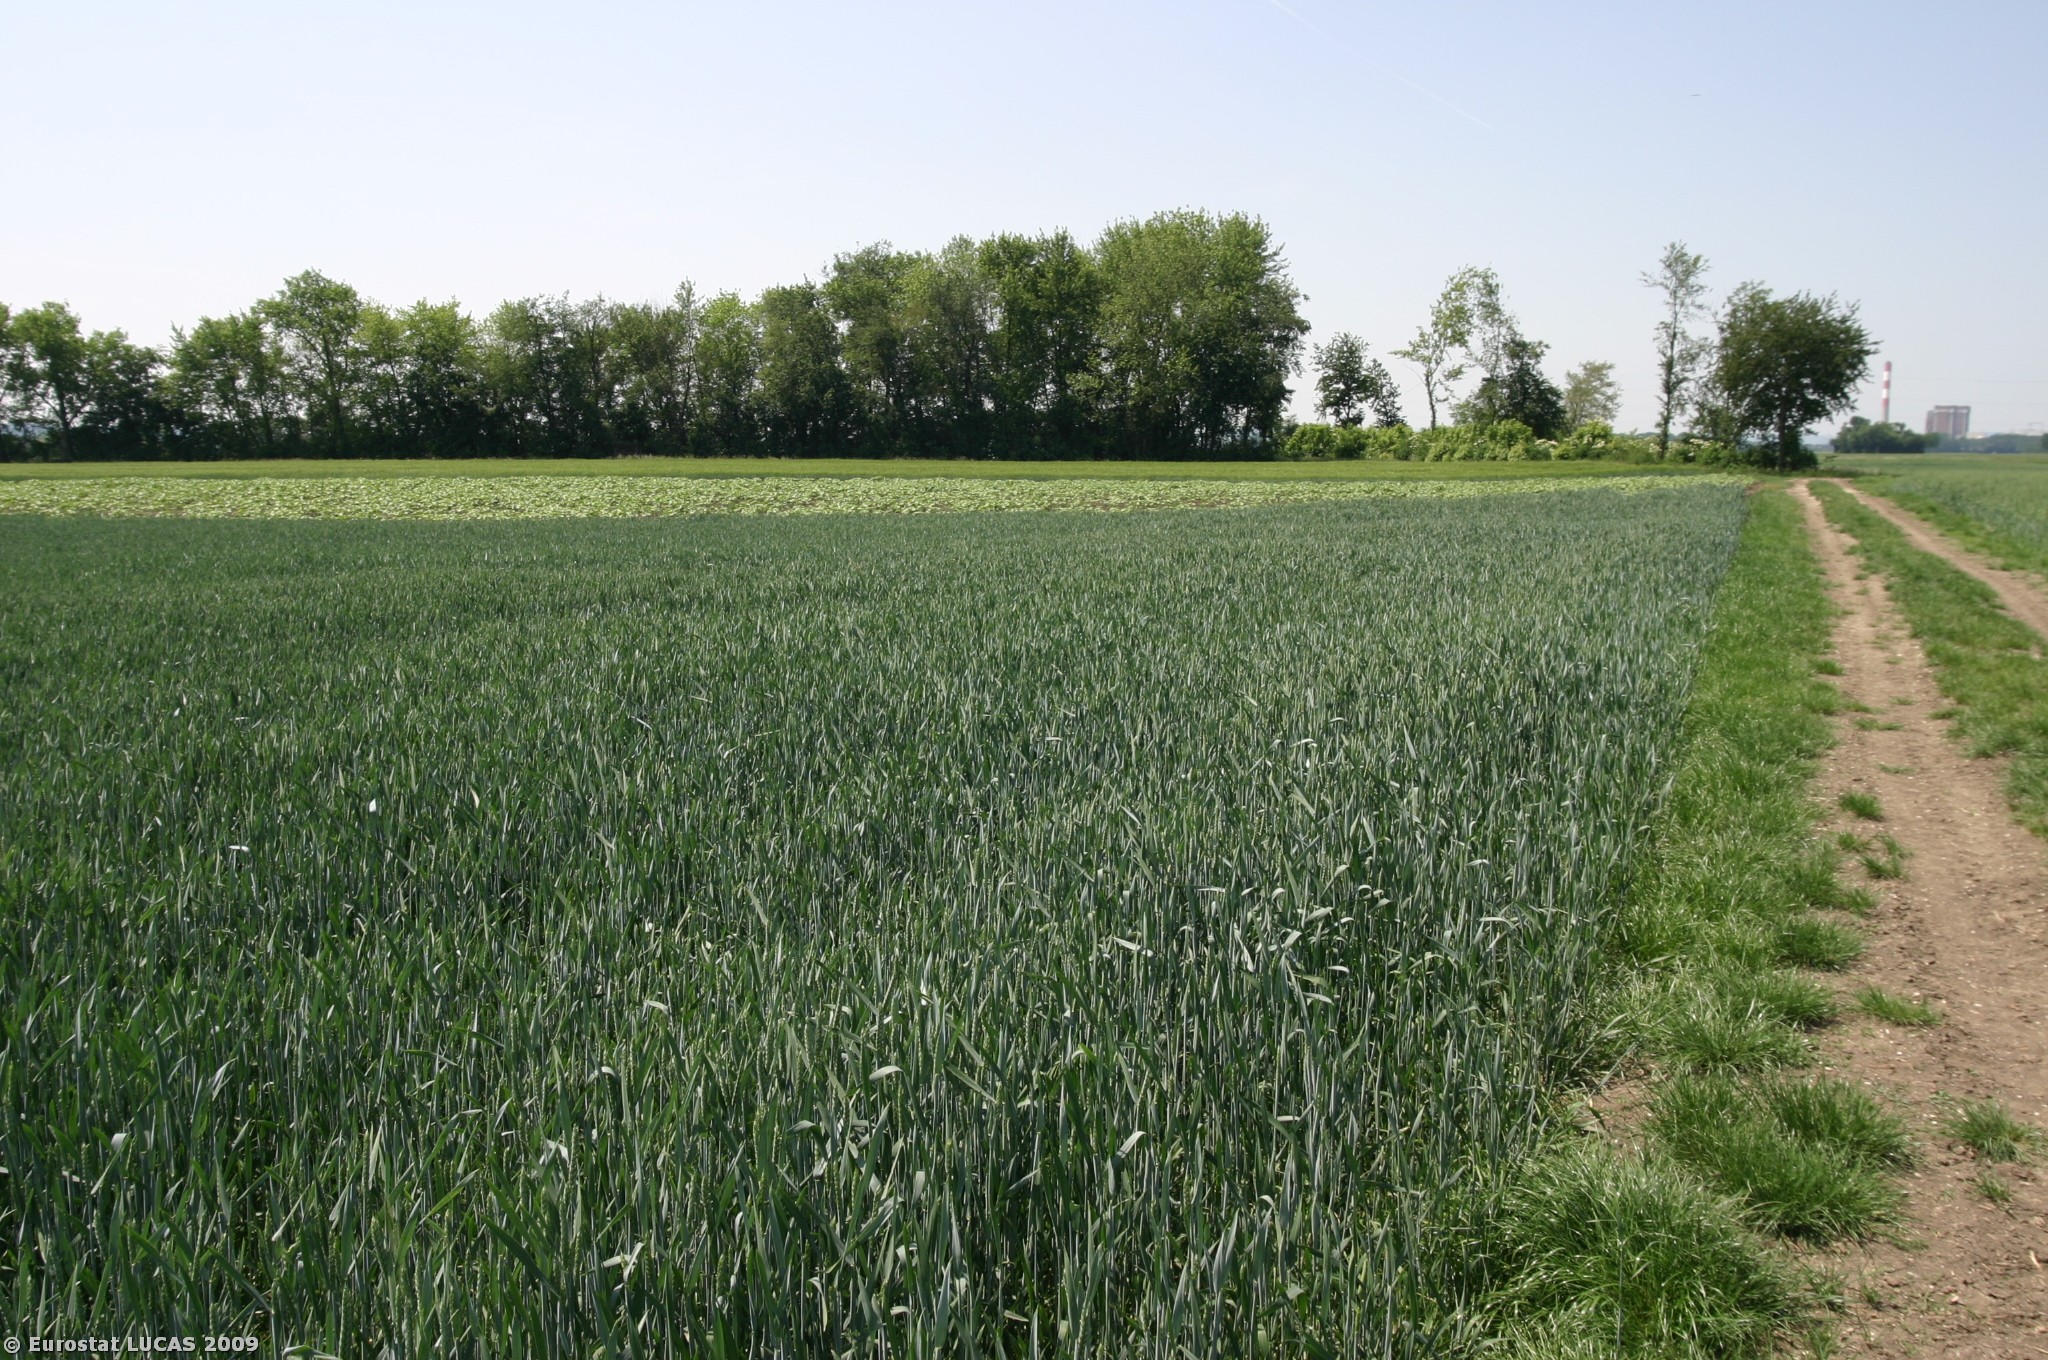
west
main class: Cropland
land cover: Common wheat
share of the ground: > 75 %
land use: Agriculture (excluding fallow land and kitchen gardens)
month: May
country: AT
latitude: 48.3139
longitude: 15.9775
